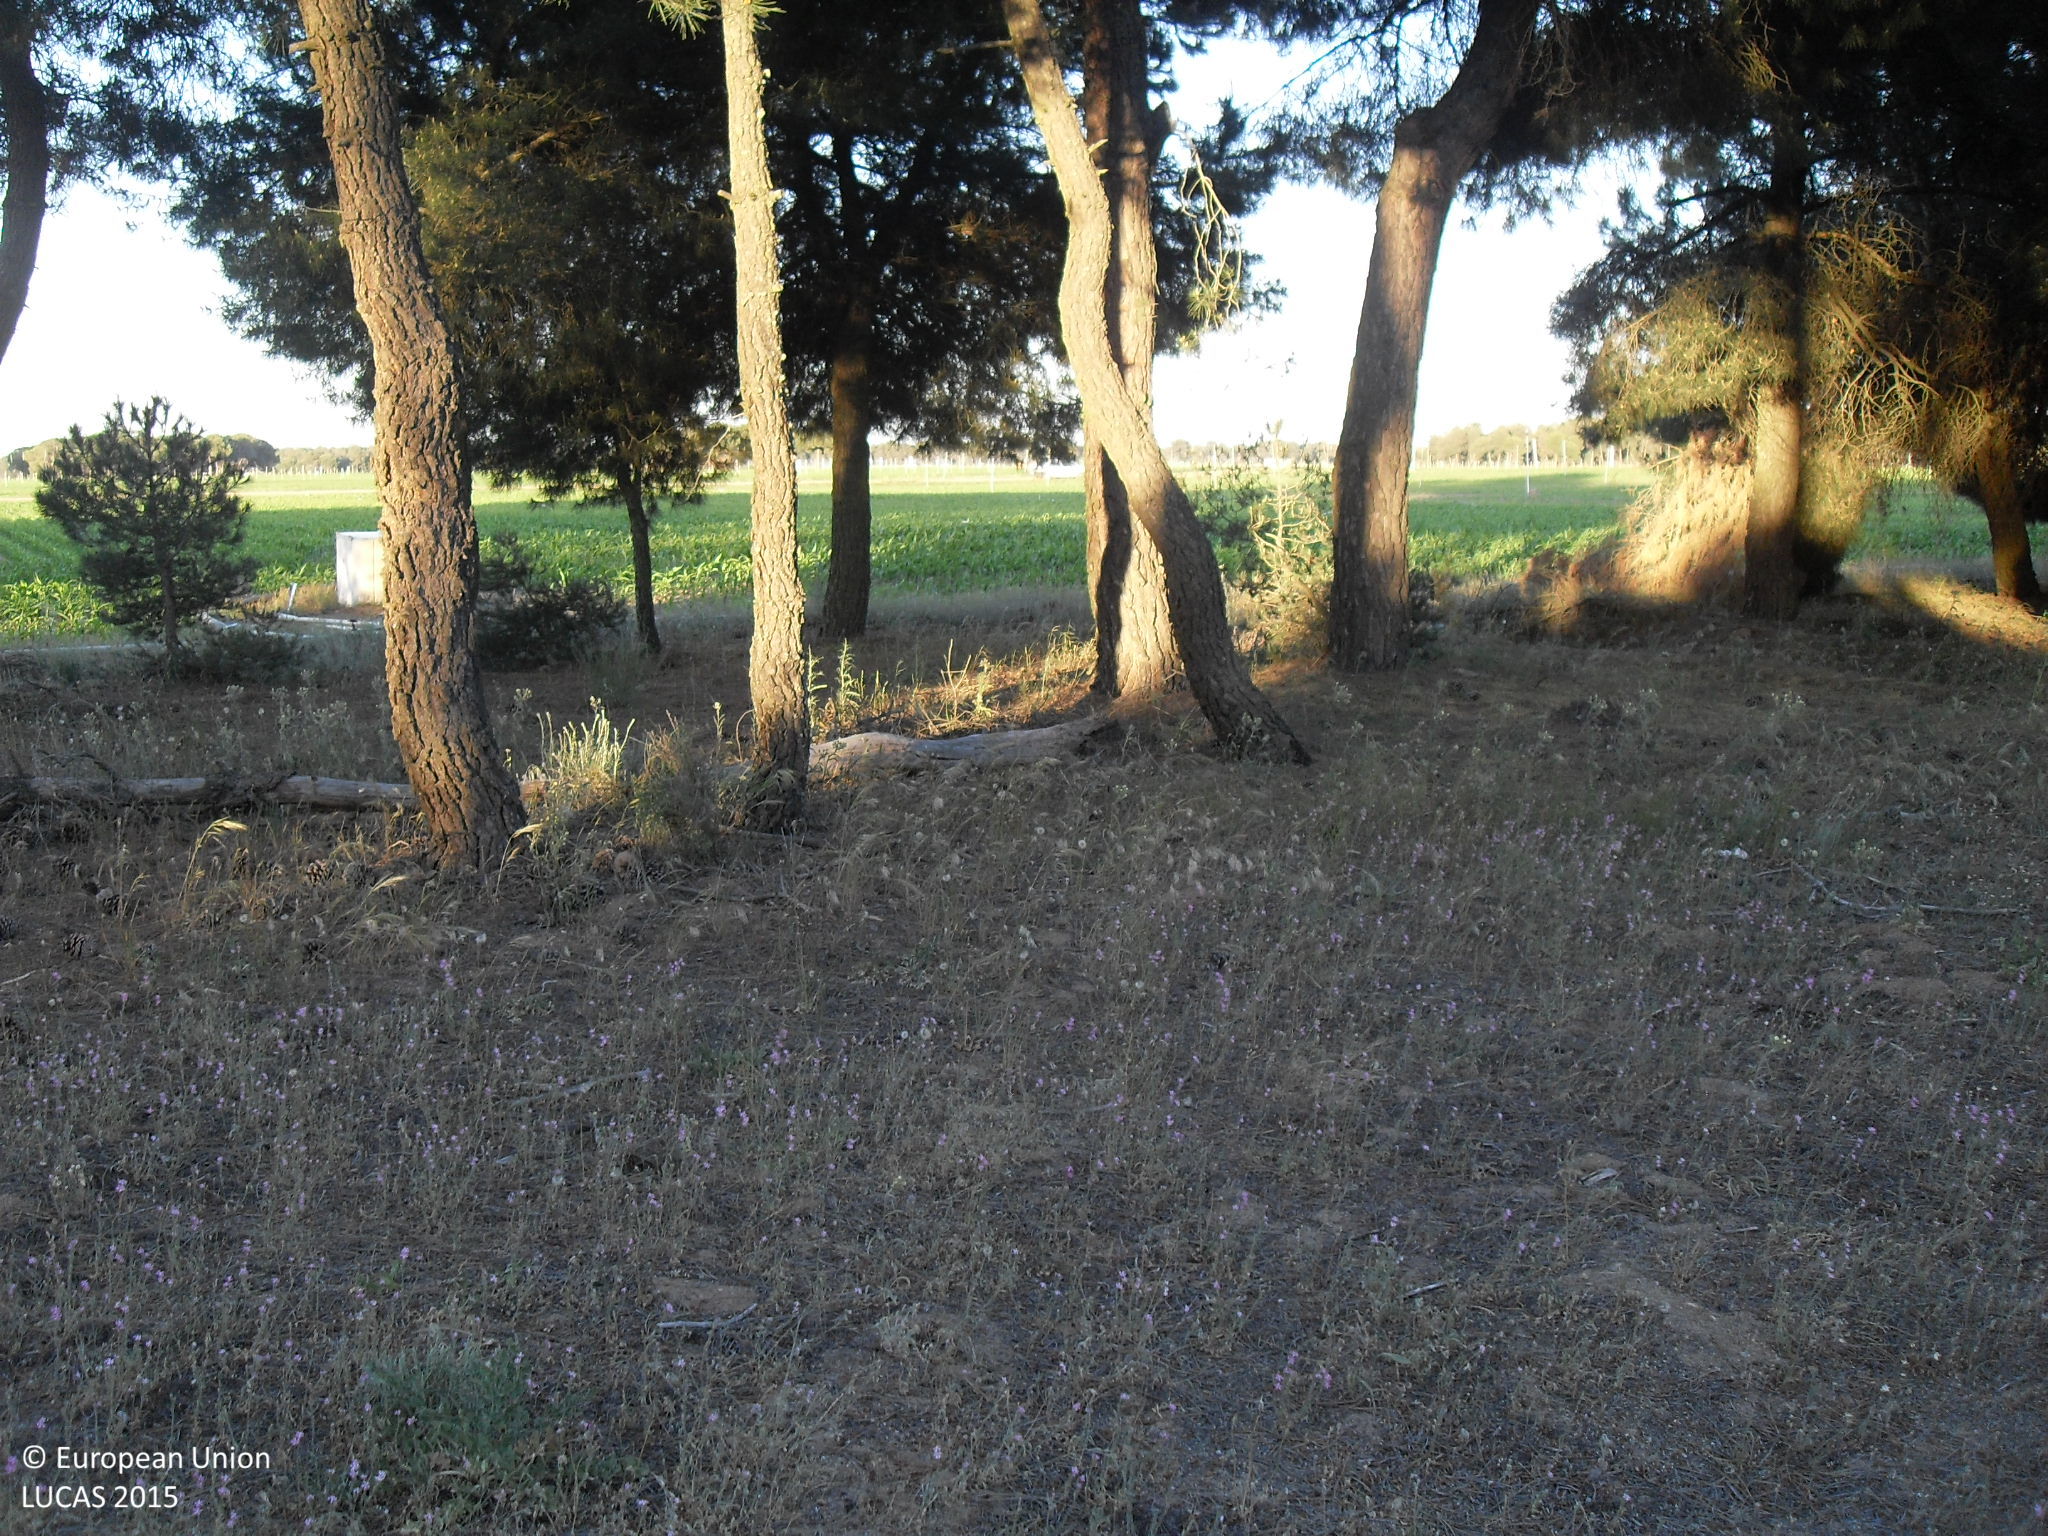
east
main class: Woodland
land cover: Pine dominated coniferous woodland
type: coniferous forest of the mediterranean region
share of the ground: 25 - 50 %
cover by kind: consolidated bare surface 60 %, coniferous forest trees 40 %
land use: Forestry
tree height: > 5 m
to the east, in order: Pine dominated coniferous woodland; Maize; Electric lines; Maize; Grass margins; Tracks; Grass margins; Maize
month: May
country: ES
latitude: 41.0306
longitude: -5.3803
